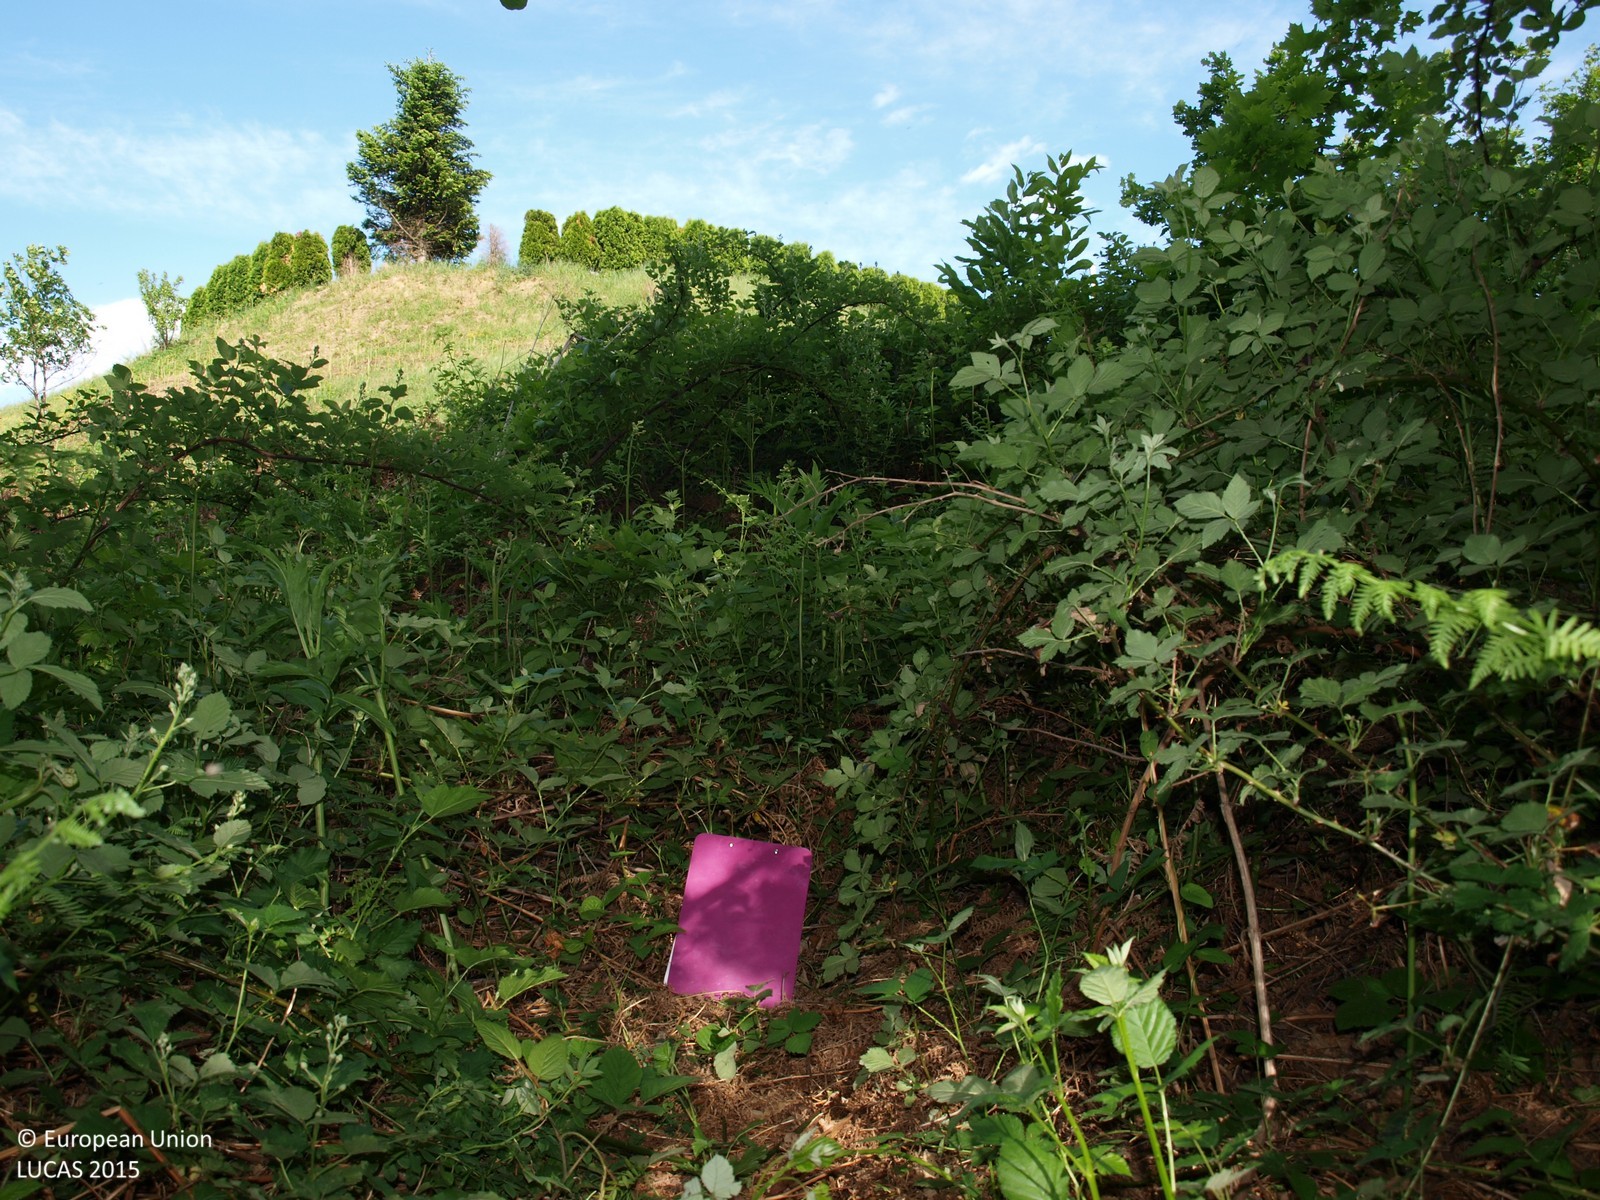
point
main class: Woodland
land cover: Broadleaved woodland
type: mesophytic deciduous forest
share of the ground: > 75 %
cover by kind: broadleaved forest trees 60 %, shrubs 30 %, herbaceous plants 10 %
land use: Forestry
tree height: > 5 m
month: May
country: HR
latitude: 46.2246
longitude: 15.8979
